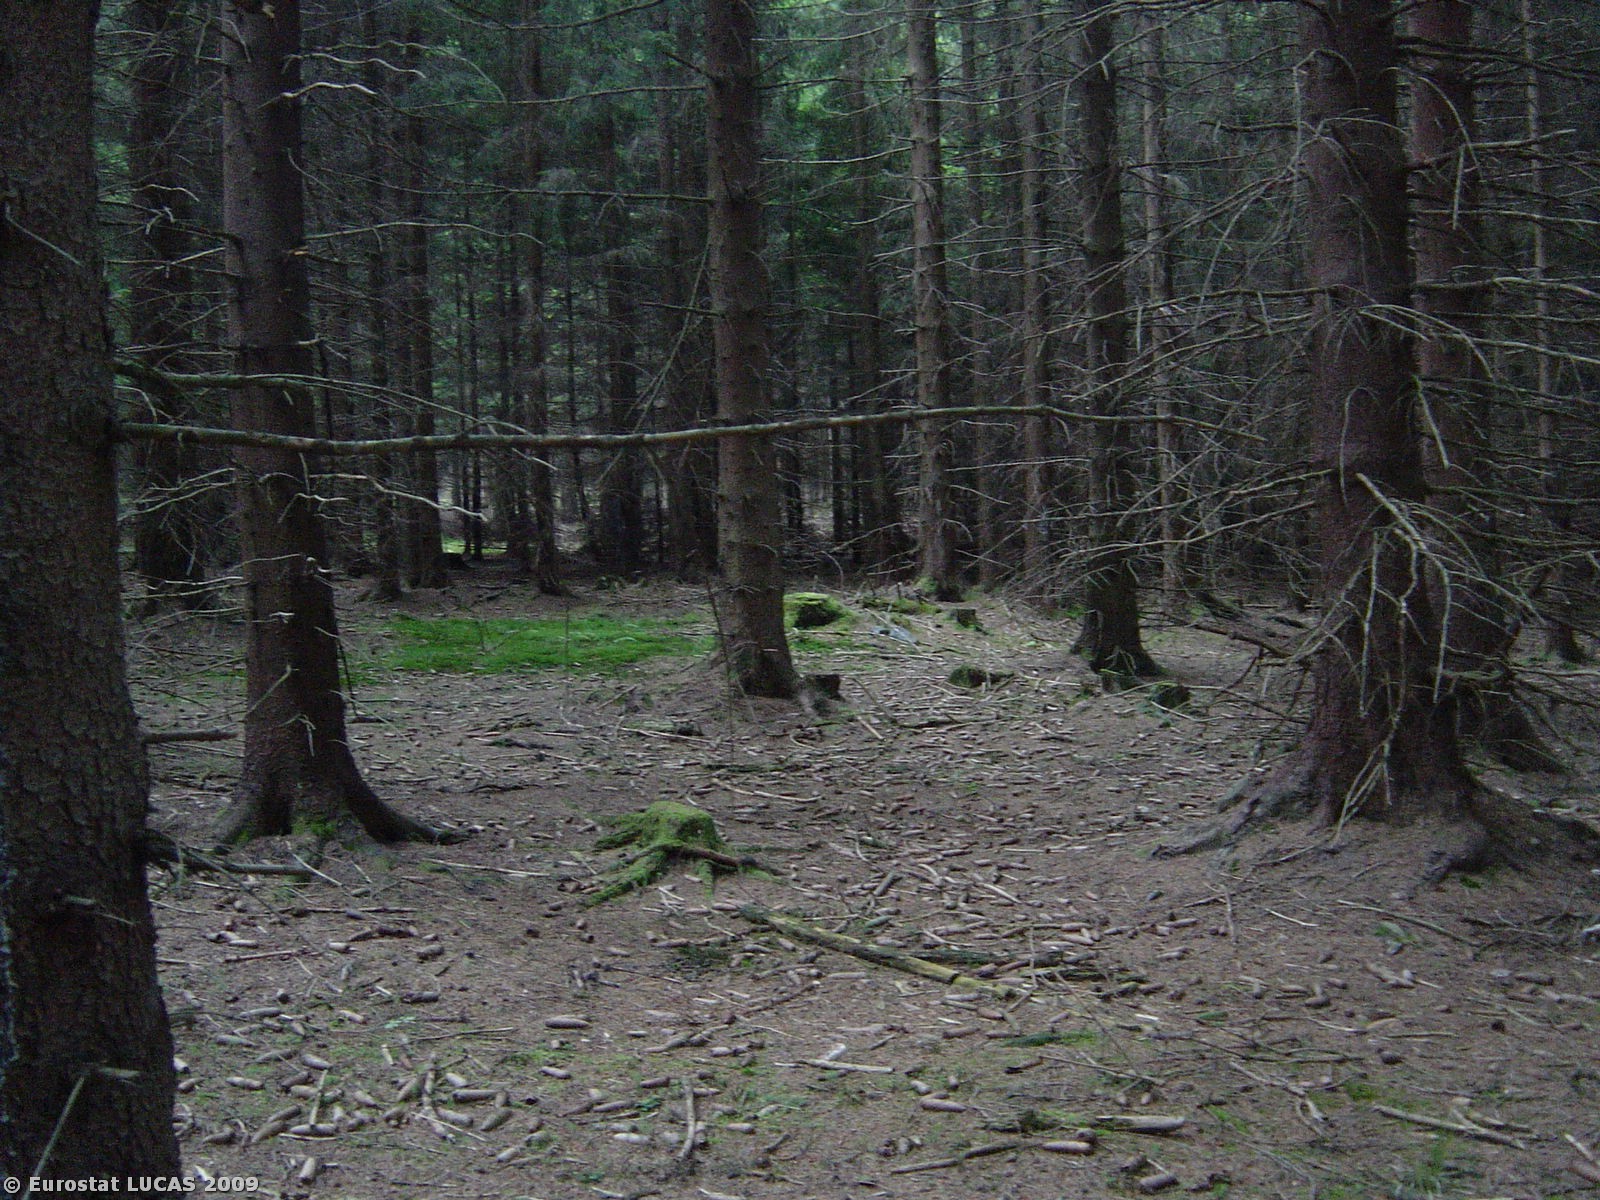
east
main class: Woodland
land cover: Coniferous woodland
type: hemiboreal forest and nemoral coniferous forest and mixed broadleaved-coniferous forest
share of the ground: > 75 %
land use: Forestry
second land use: Nature reserves
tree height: > 5 m
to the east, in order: Coniferous woodland; Tracks; Coniferous woodland; Tracks; Coniferous woodland
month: July
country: CZ
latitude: 49.8147
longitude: 12.5151
